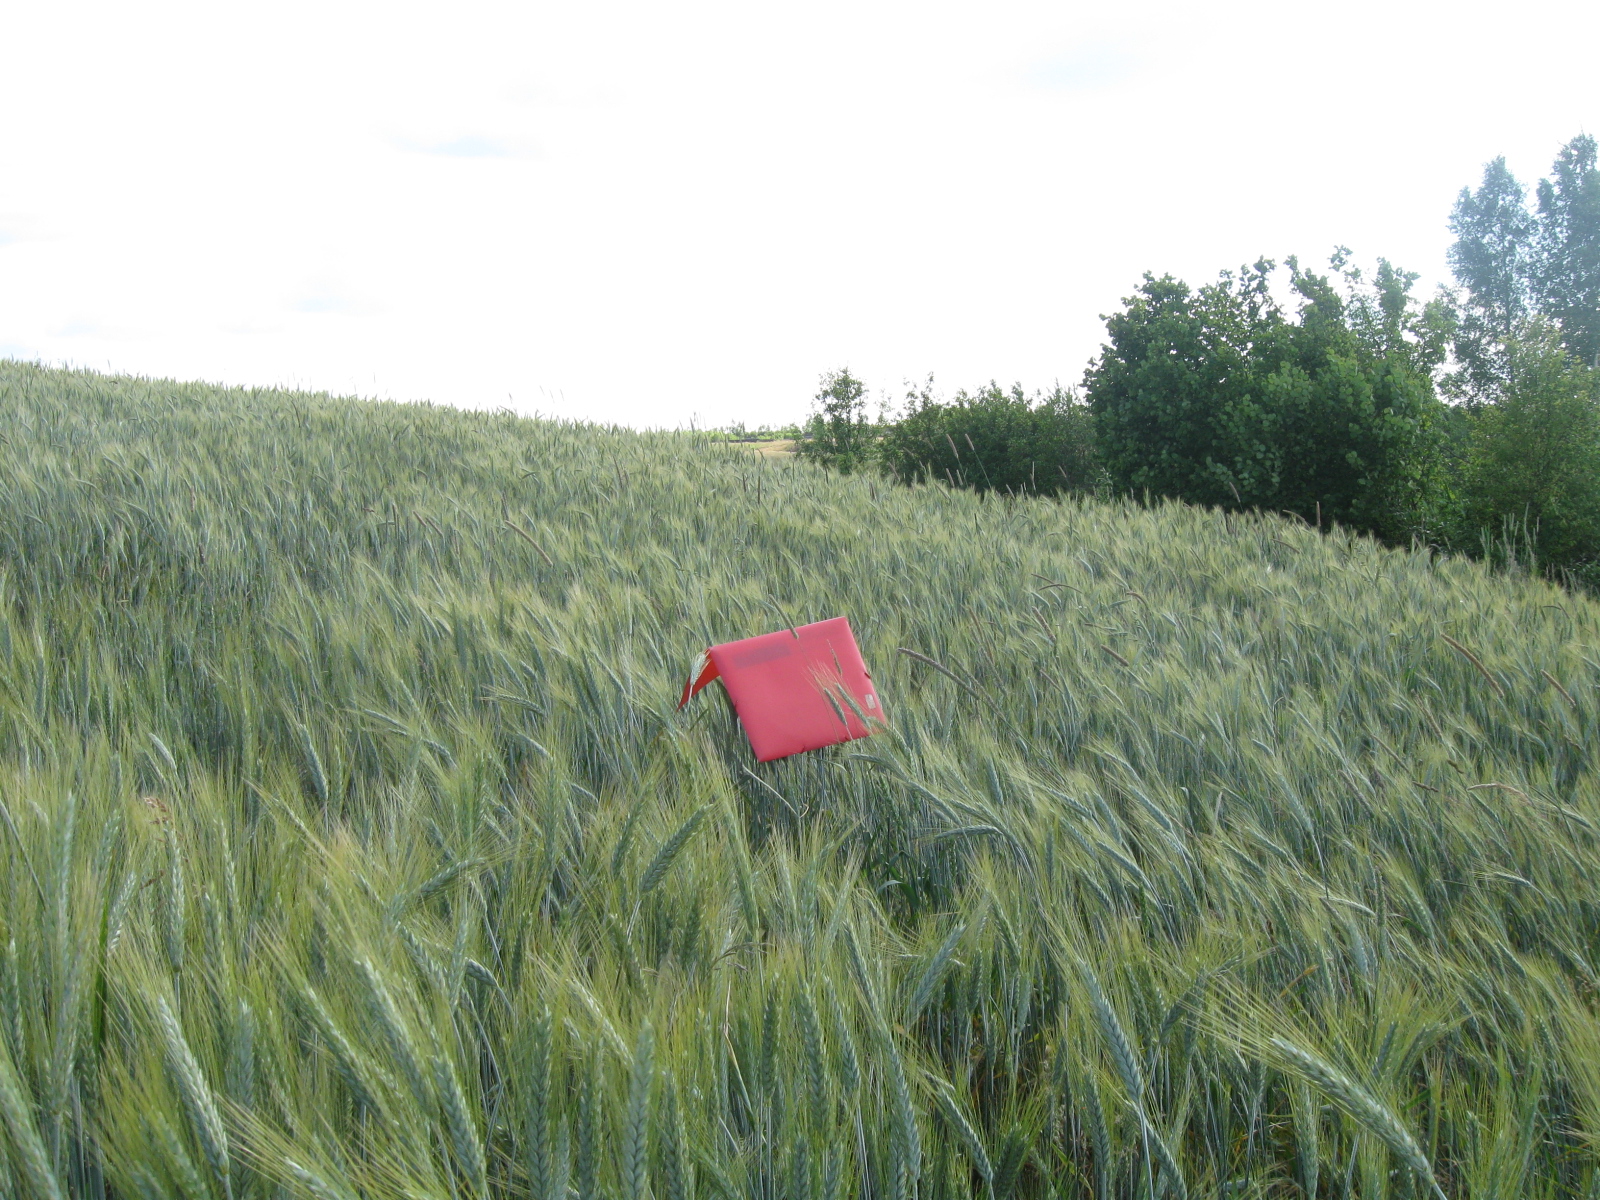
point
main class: Cropland
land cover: Triticale
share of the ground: > 75 %
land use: Agriculture (excluding fallow land and kitchen gardens)
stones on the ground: < 10 %
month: July
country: LT
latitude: 54.2477
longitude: 24.2949
